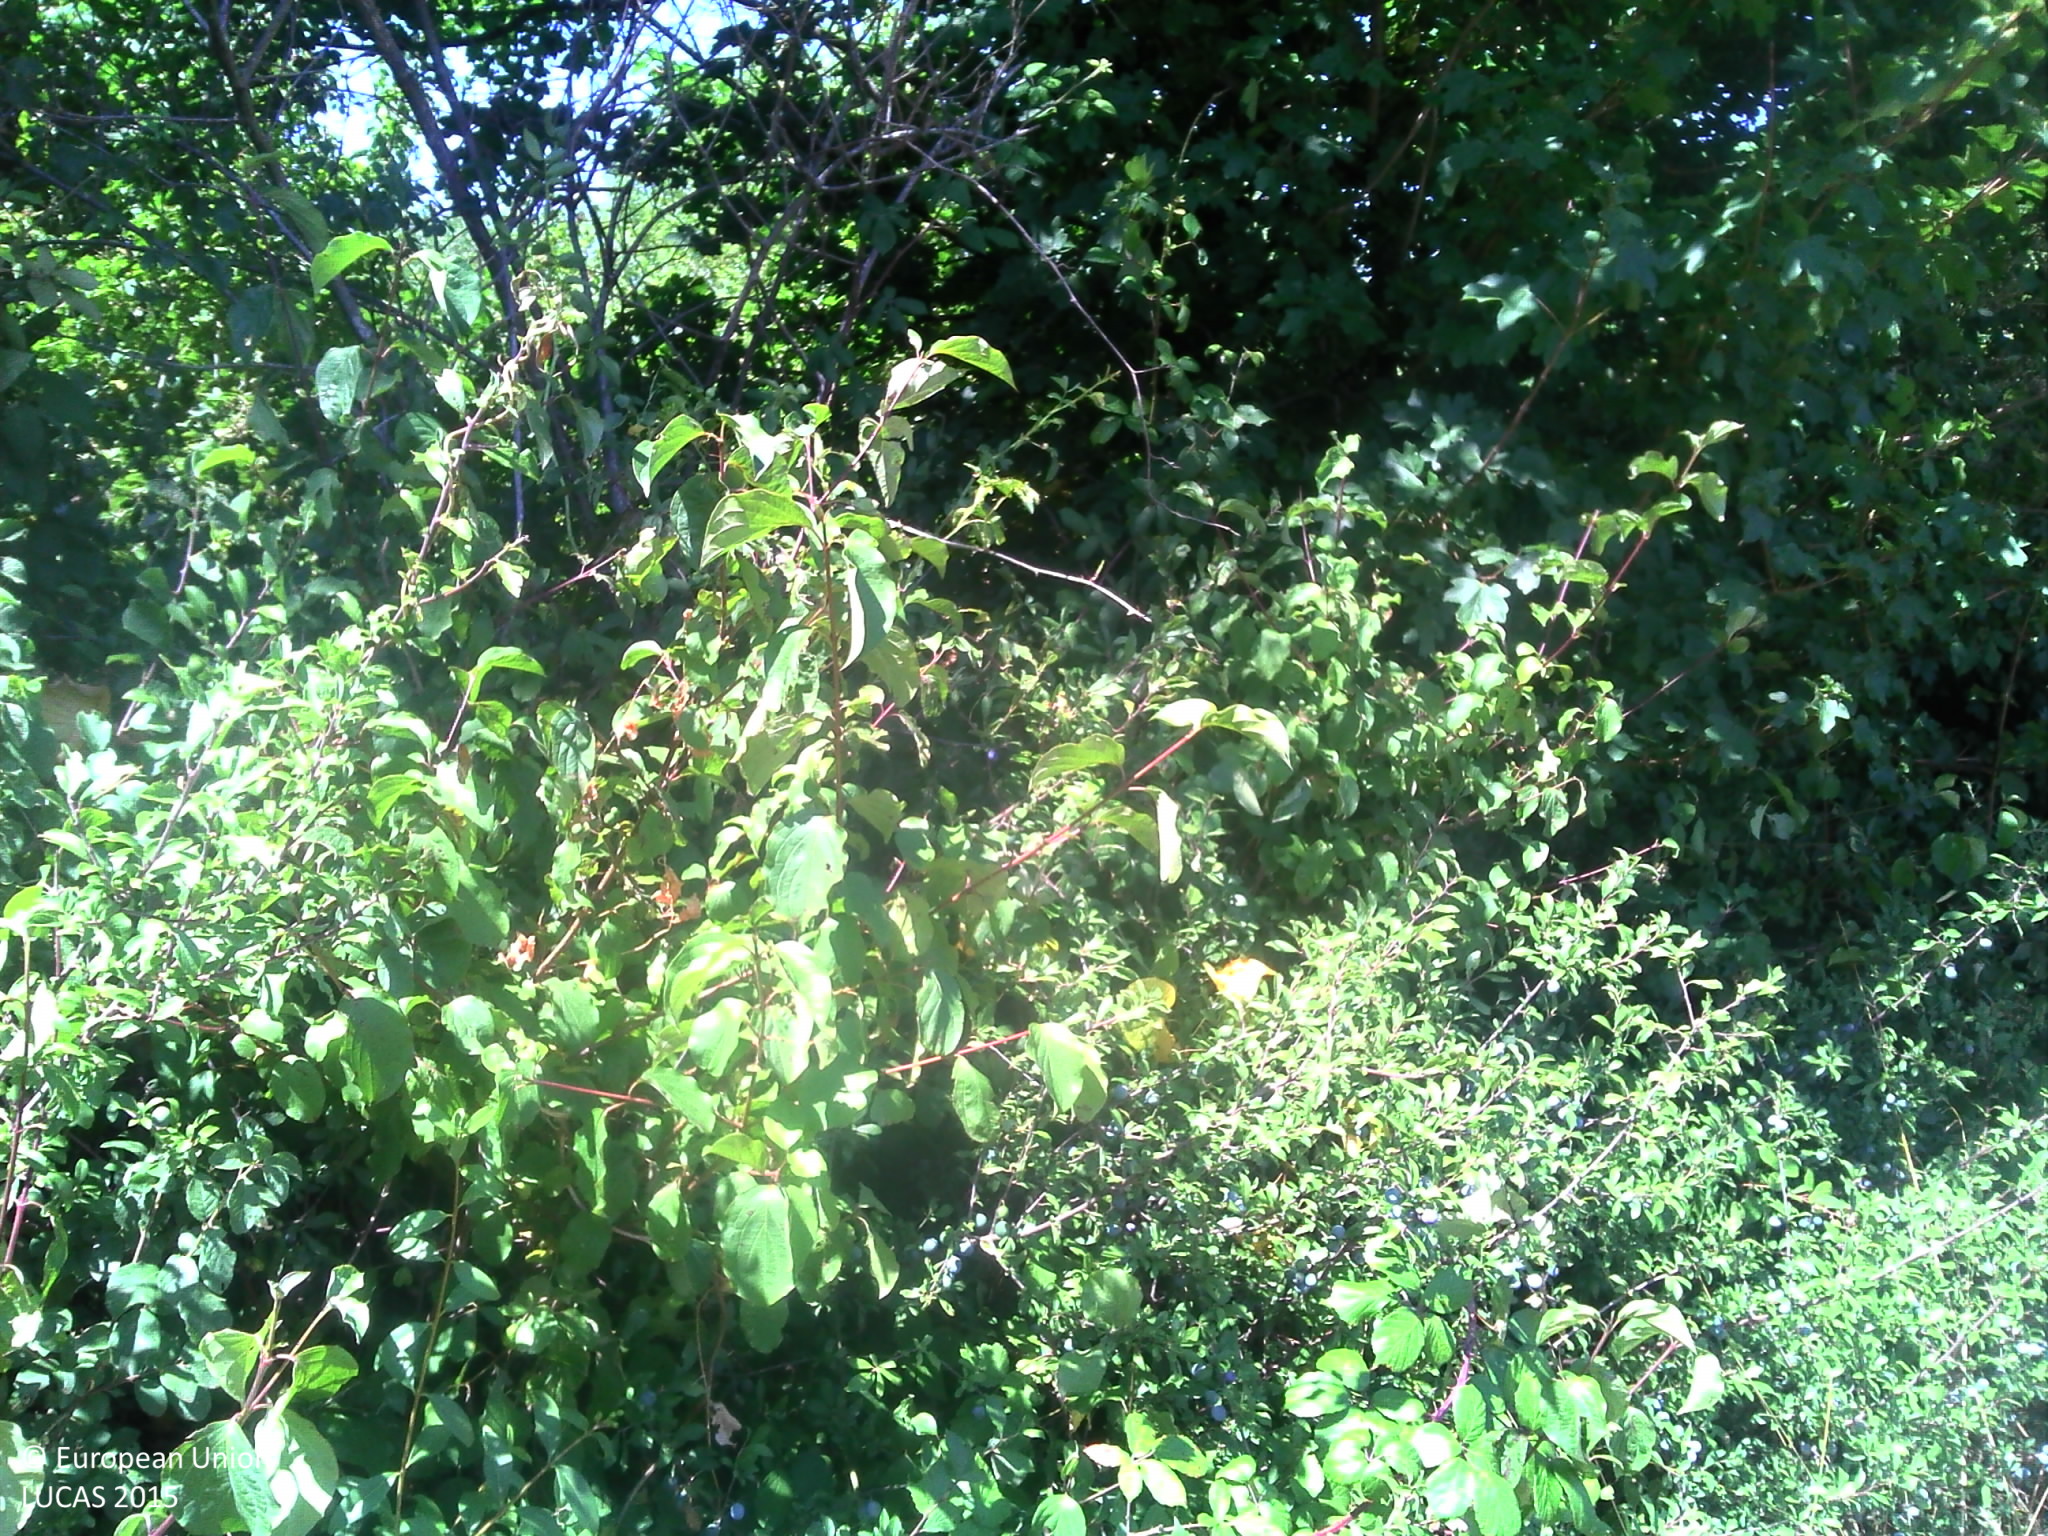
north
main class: Woodland
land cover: Broadleaved woodland
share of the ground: > 75 %
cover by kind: broadleaved forest trees 90 %, shrubs 5 %, herbaceous plants 5 %
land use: Semi-natural and natural areas not in use
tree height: < 5 m
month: July
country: FR
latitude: 45.5985
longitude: 4.9145
